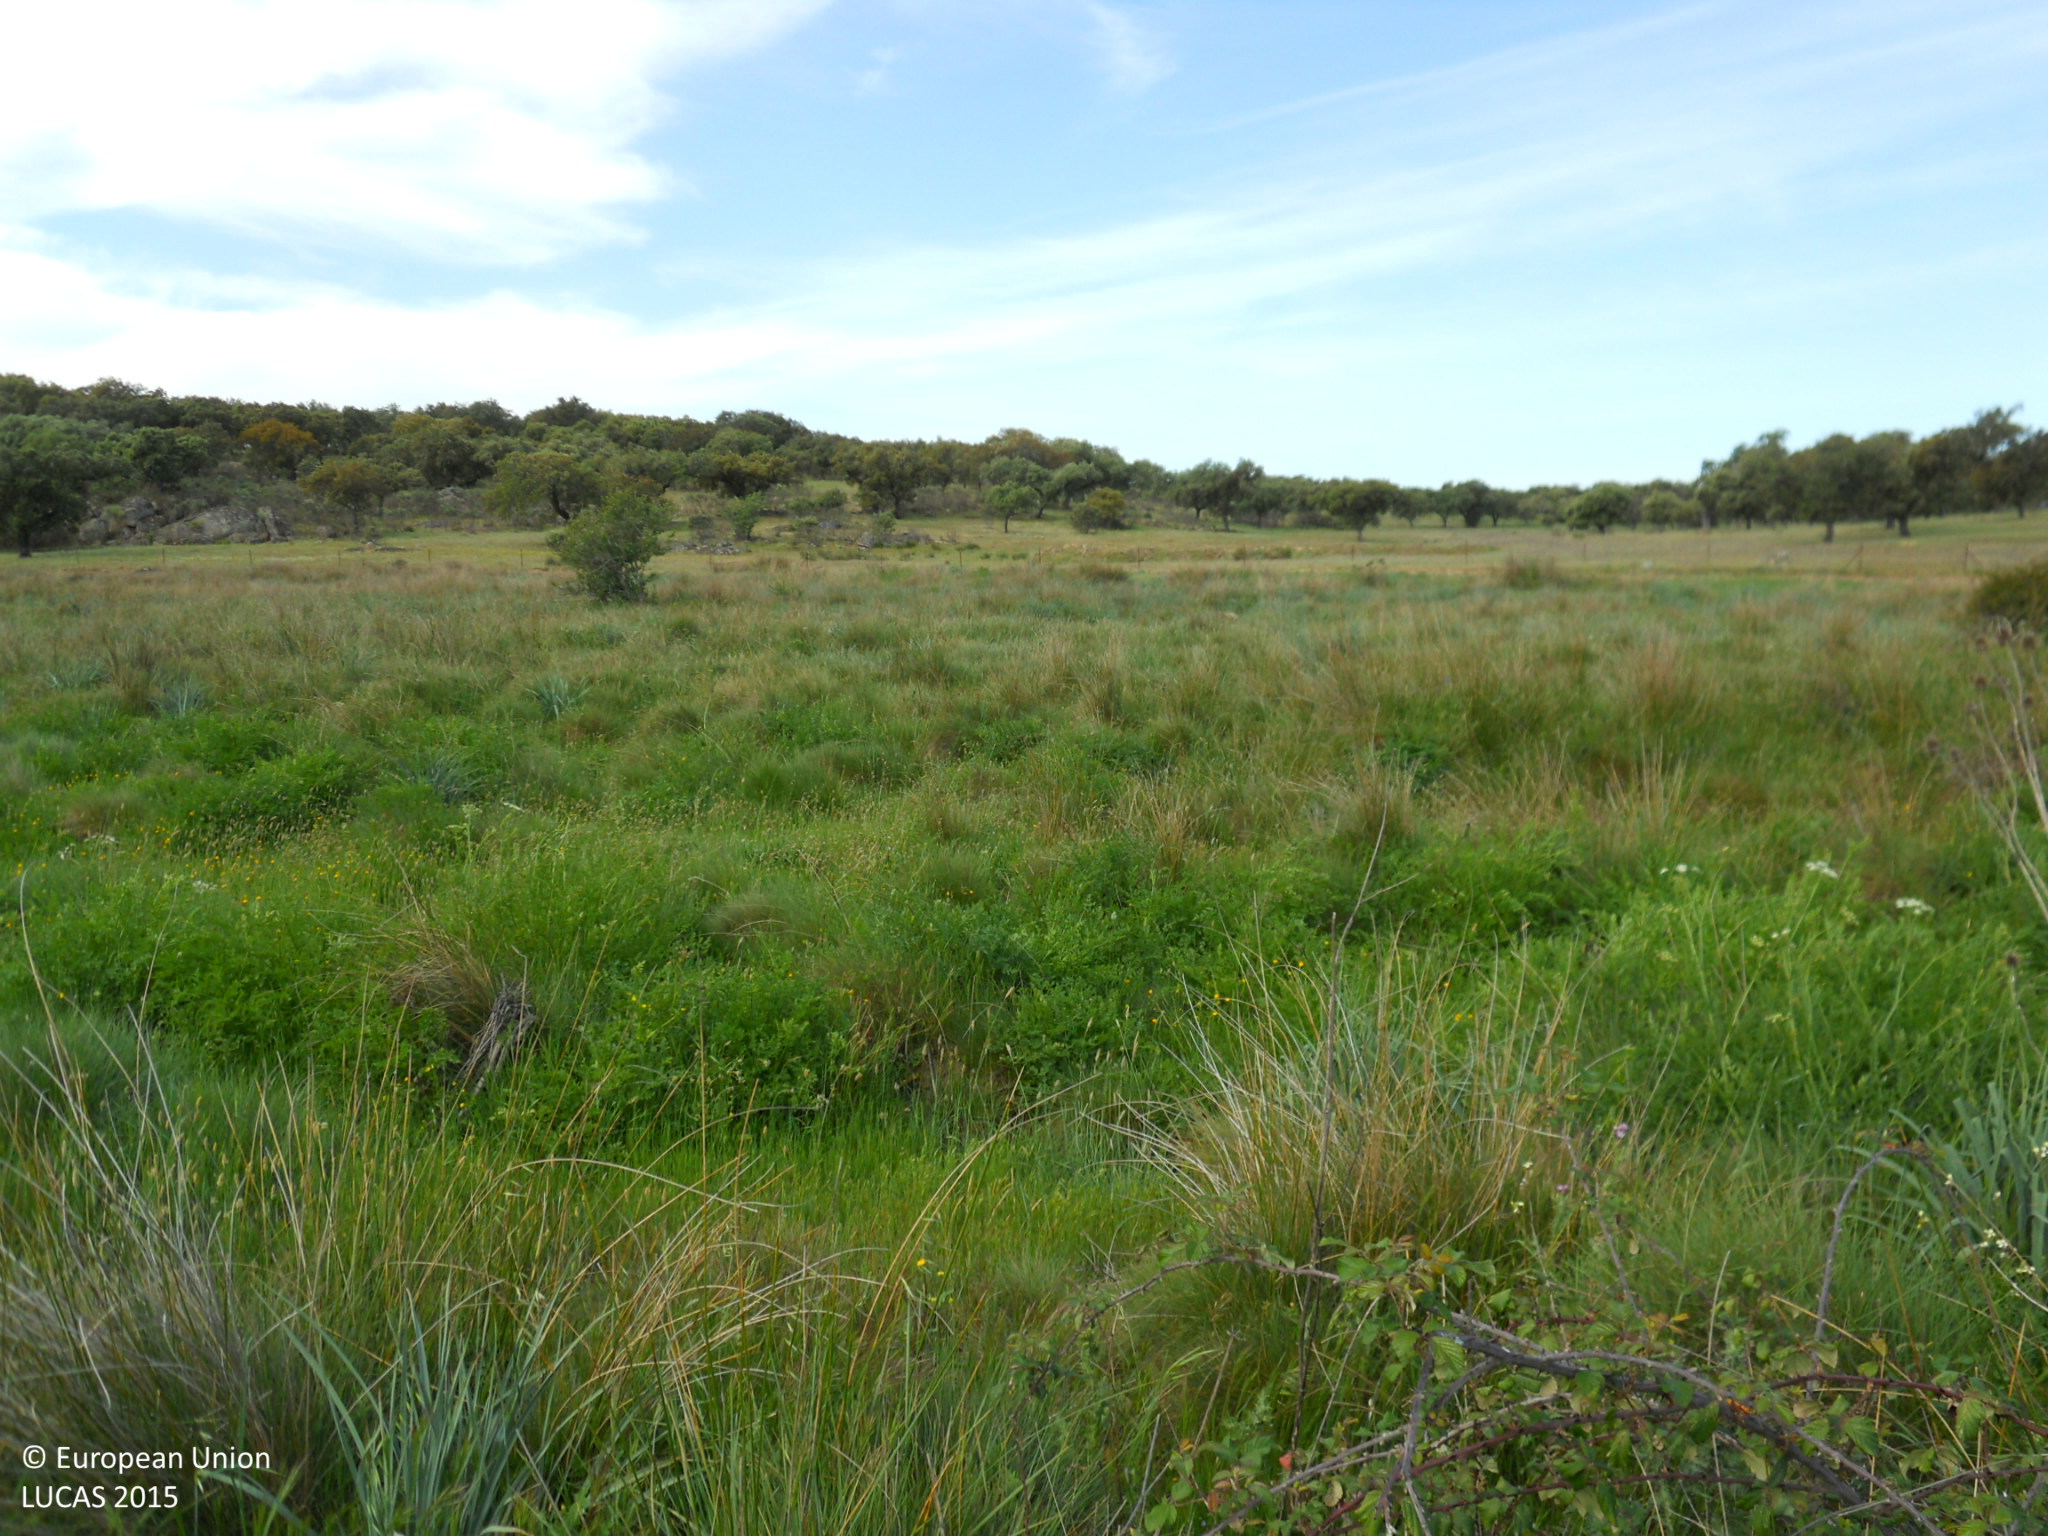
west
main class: Shrubland
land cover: Shrubland with sparse tree cover
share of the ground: > 75 %
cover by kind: shrubs 50 %, herbaceous plants 45 %, broadleaved forest trees 5 %
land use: Semi-natural and natural areas not in use
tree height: < 5 m
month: April
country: ES
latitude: 39.3186
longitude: -6.9301
